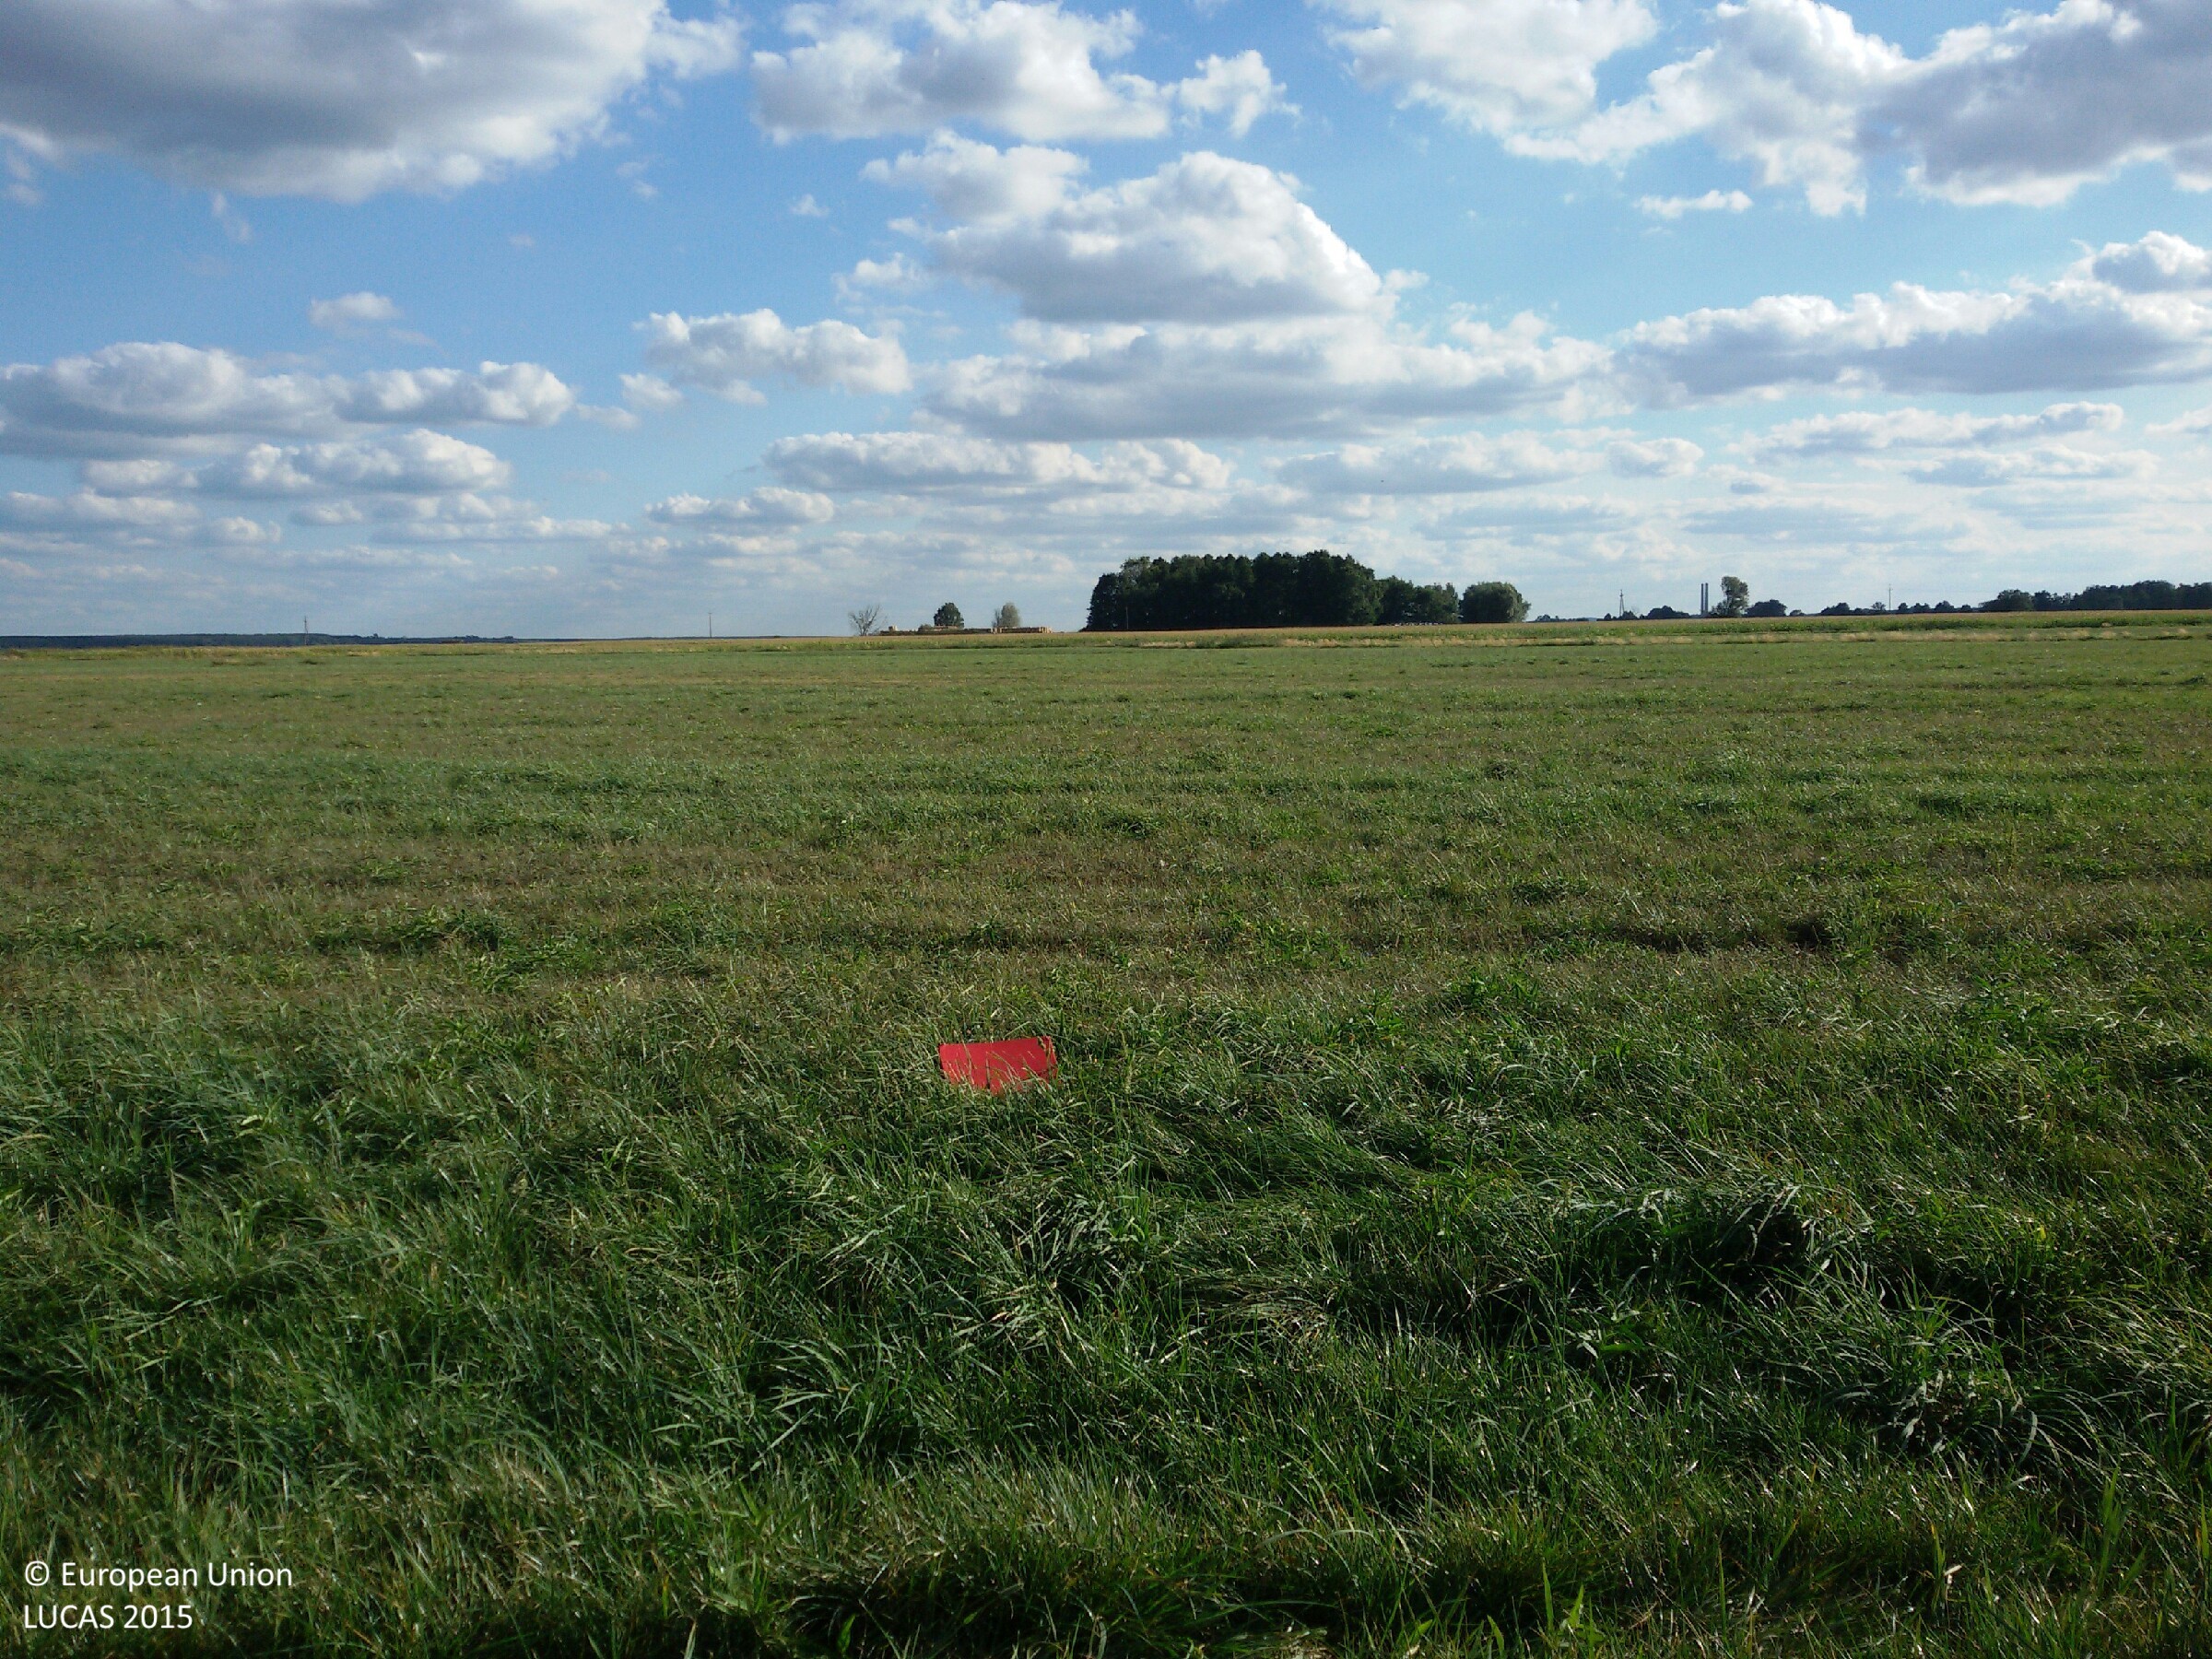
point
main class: Grassland
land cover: Grassland without tree/shrub cover
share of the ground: > 75 %
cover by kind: herbaceous plants 100 %
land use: Agriculture (excluding fallow land and kitchen gardens)
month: September
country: PL
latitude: 52.2113
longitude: 14.7292
